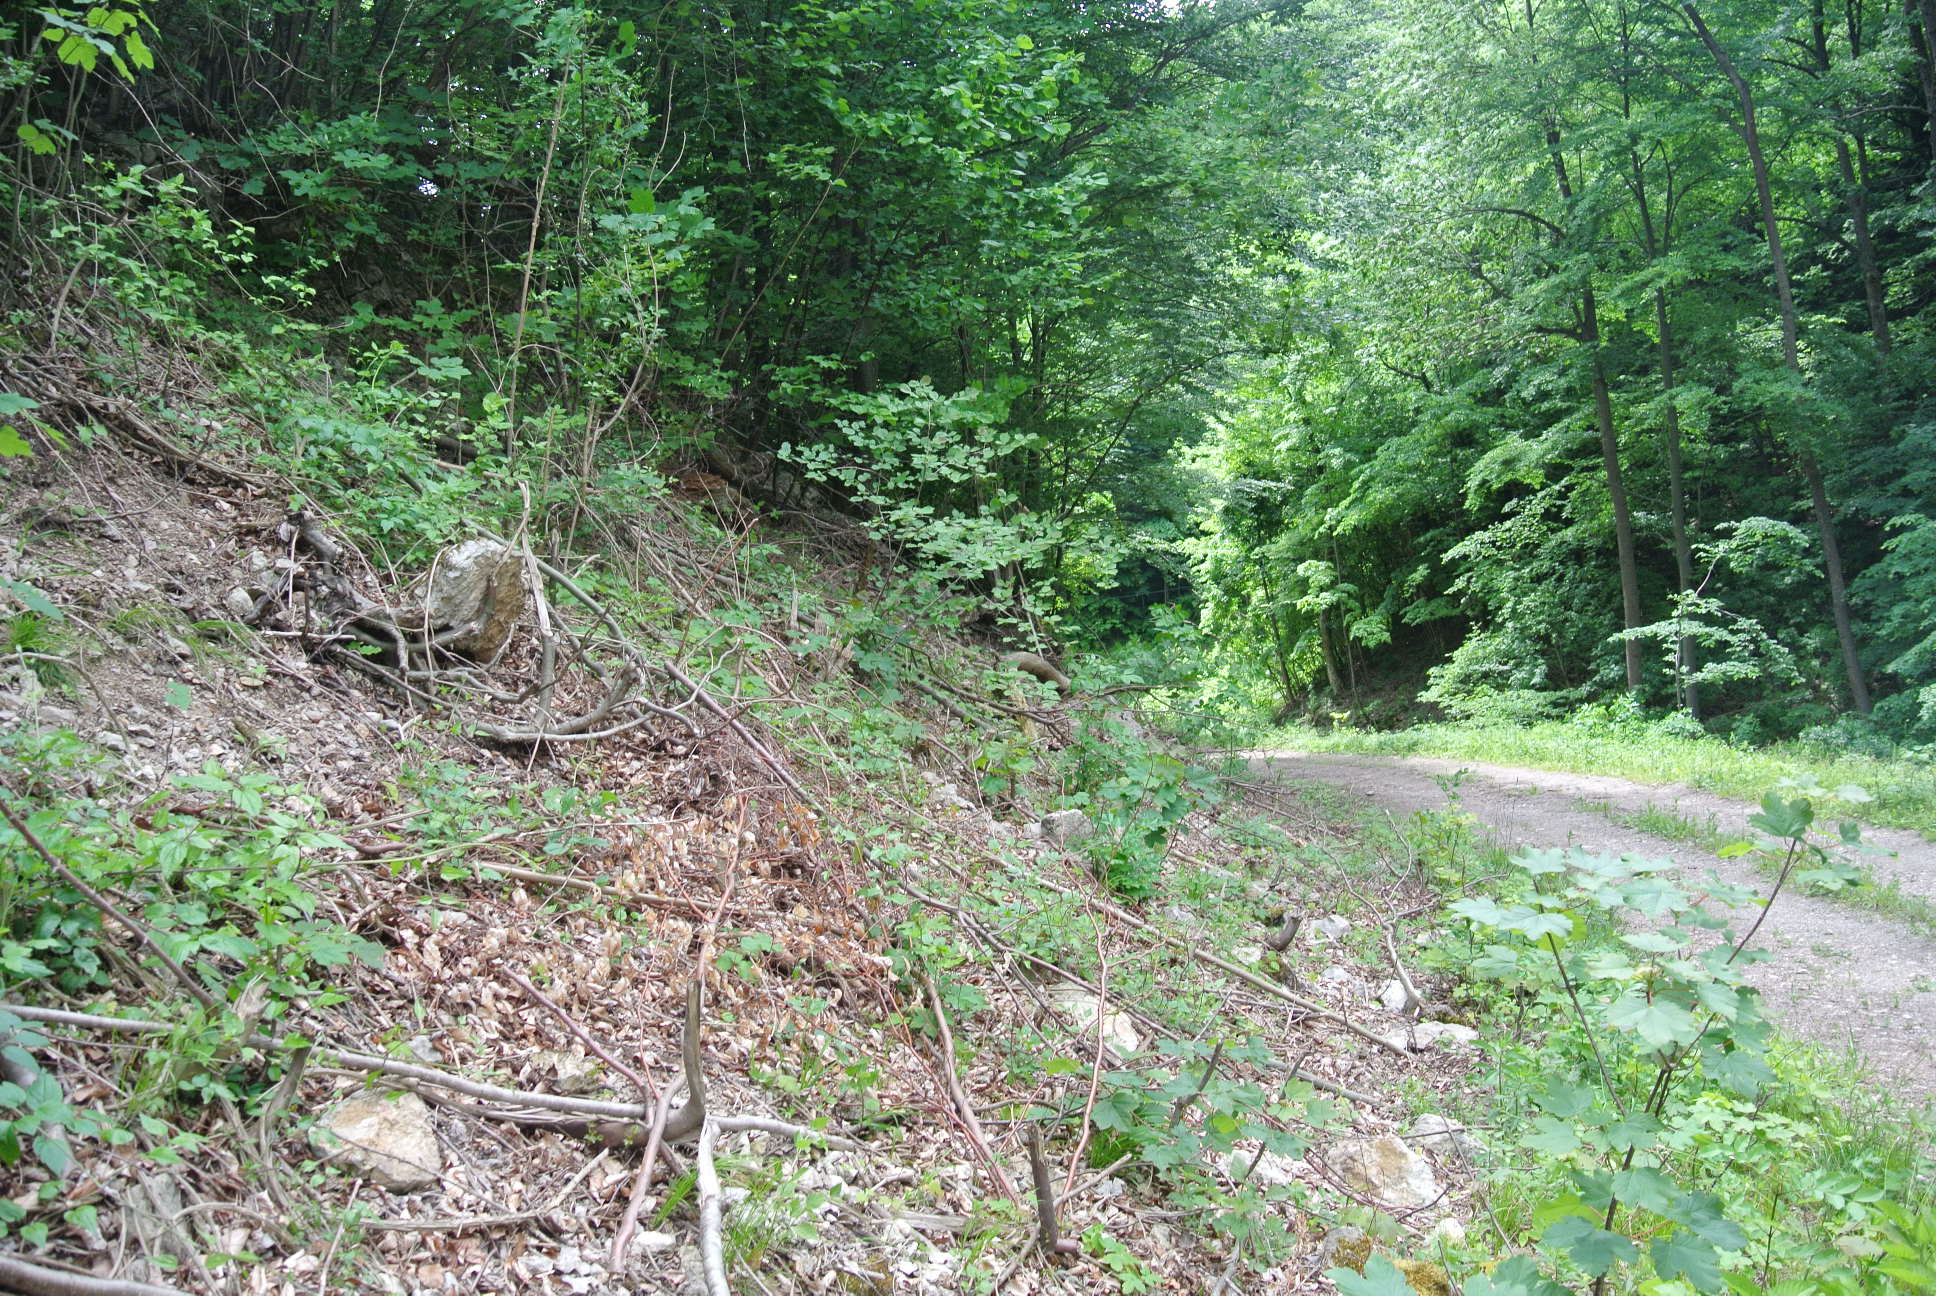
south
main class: Grassland
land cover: Spontaneously vegetated surfaces
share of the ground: > 75 %
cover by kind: herbaceous plants 95 %, shrubs 5 %
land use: Forestry
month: June
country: AT
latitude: 48.0004
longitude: 16.1019
